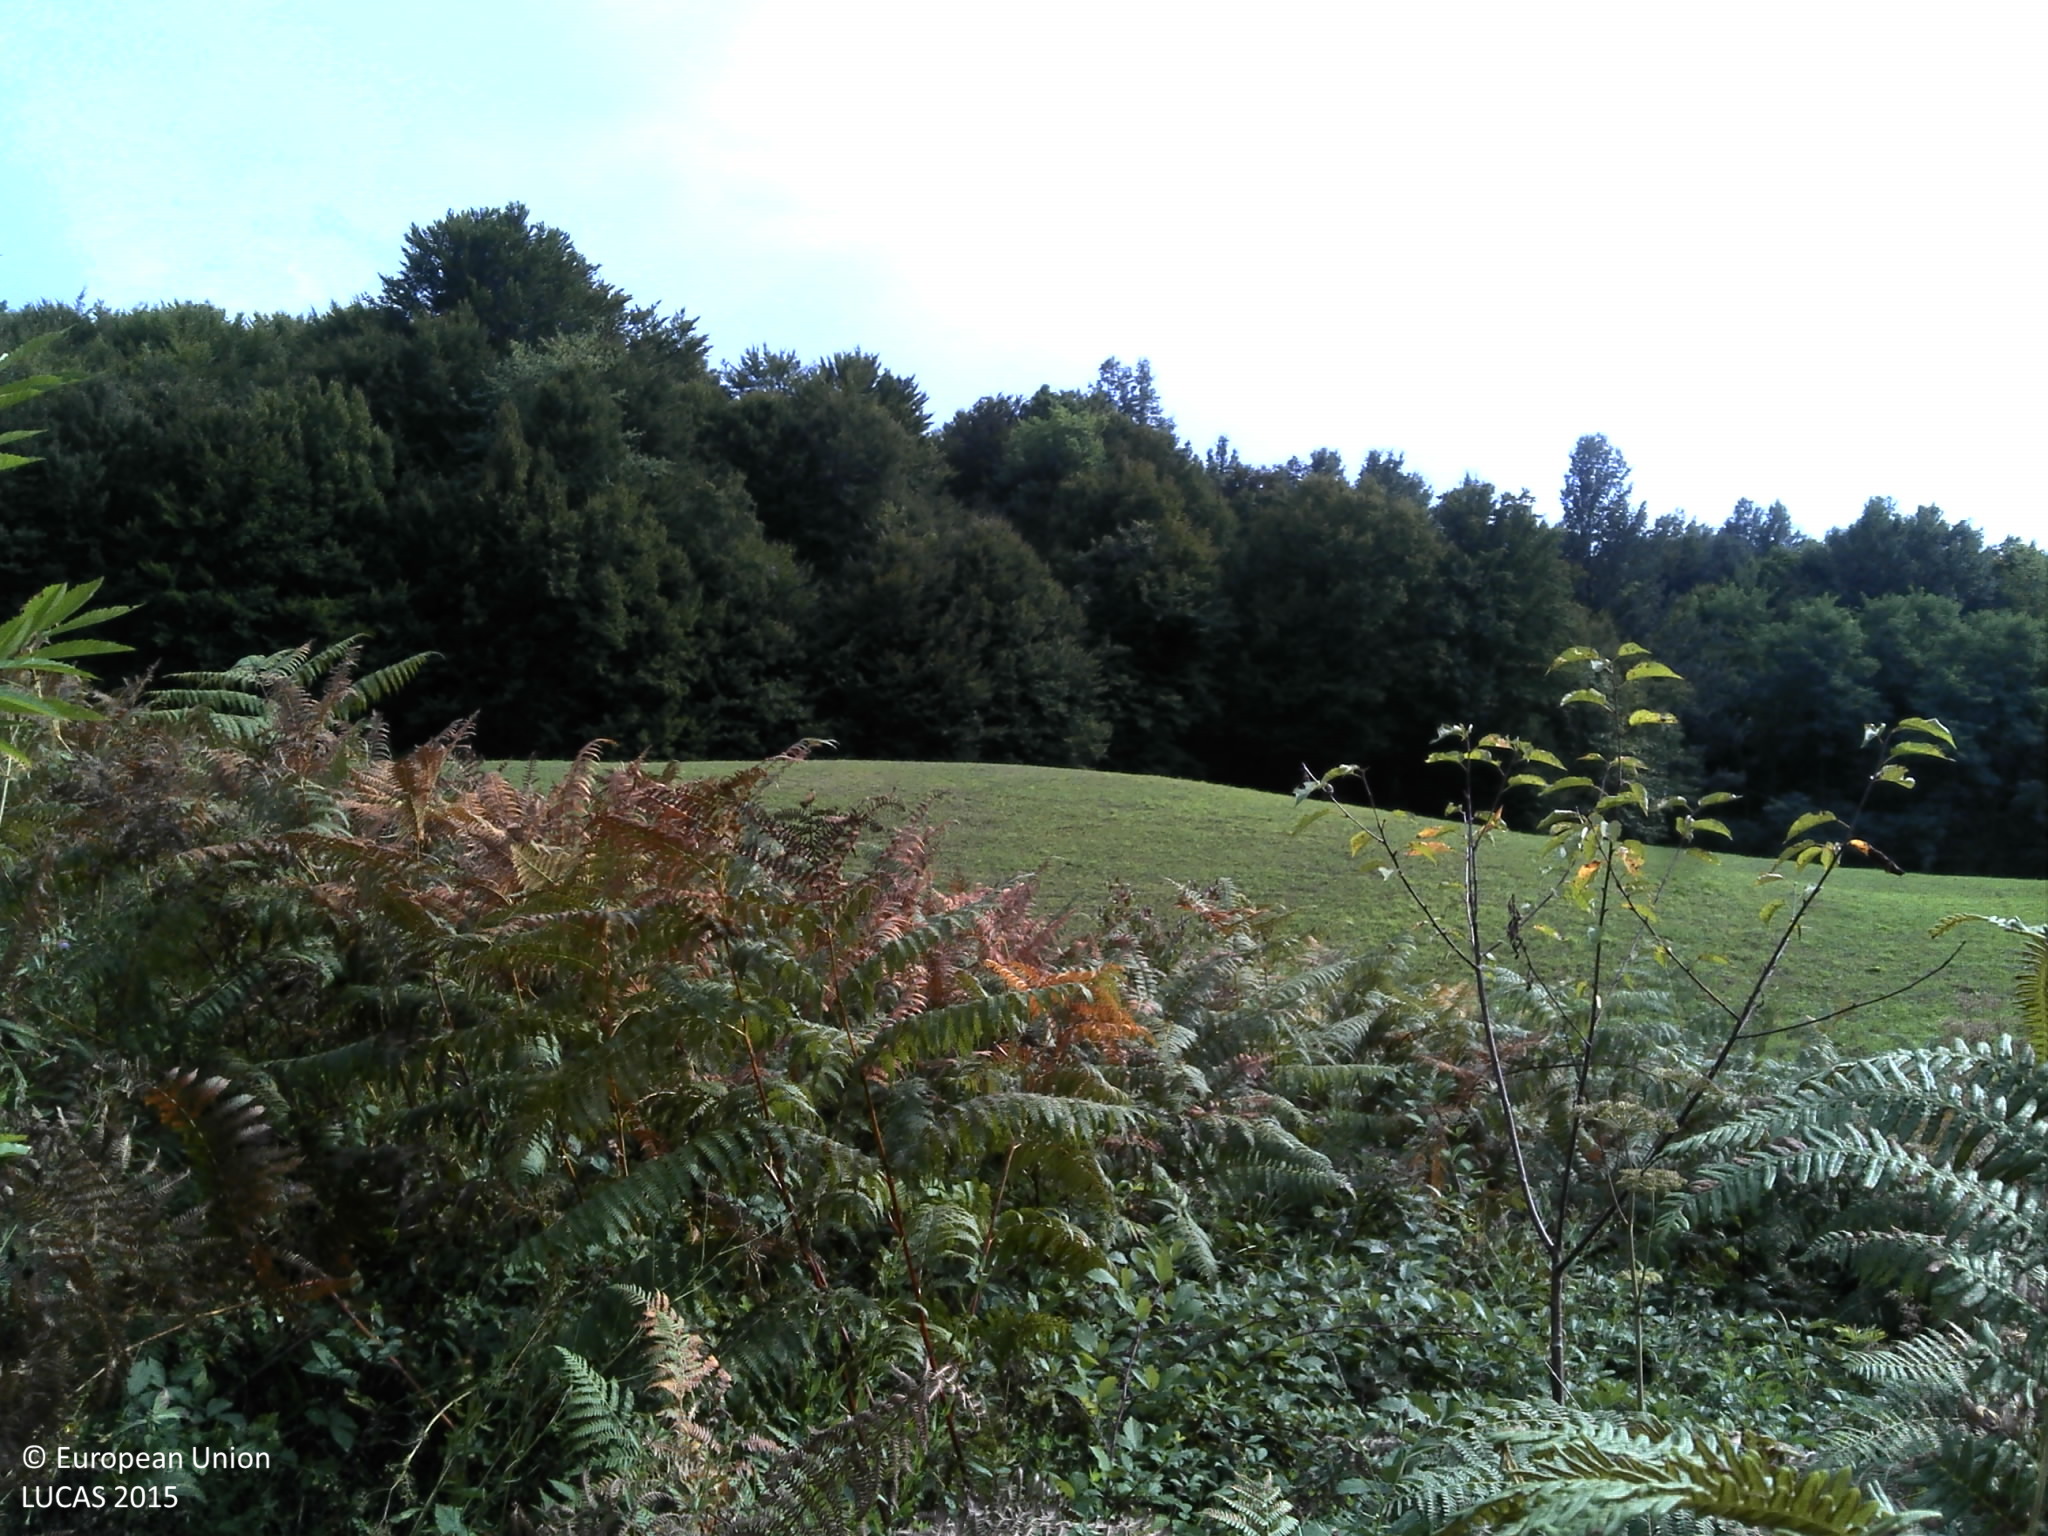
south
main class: Shrubland
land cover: Shrubland without tree cover
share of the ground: > 75 %
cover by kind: shrubs 100 %
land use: Semi-natural and natural areas not in use
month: September
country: HR
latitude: 45.1361
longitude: 15.6540
